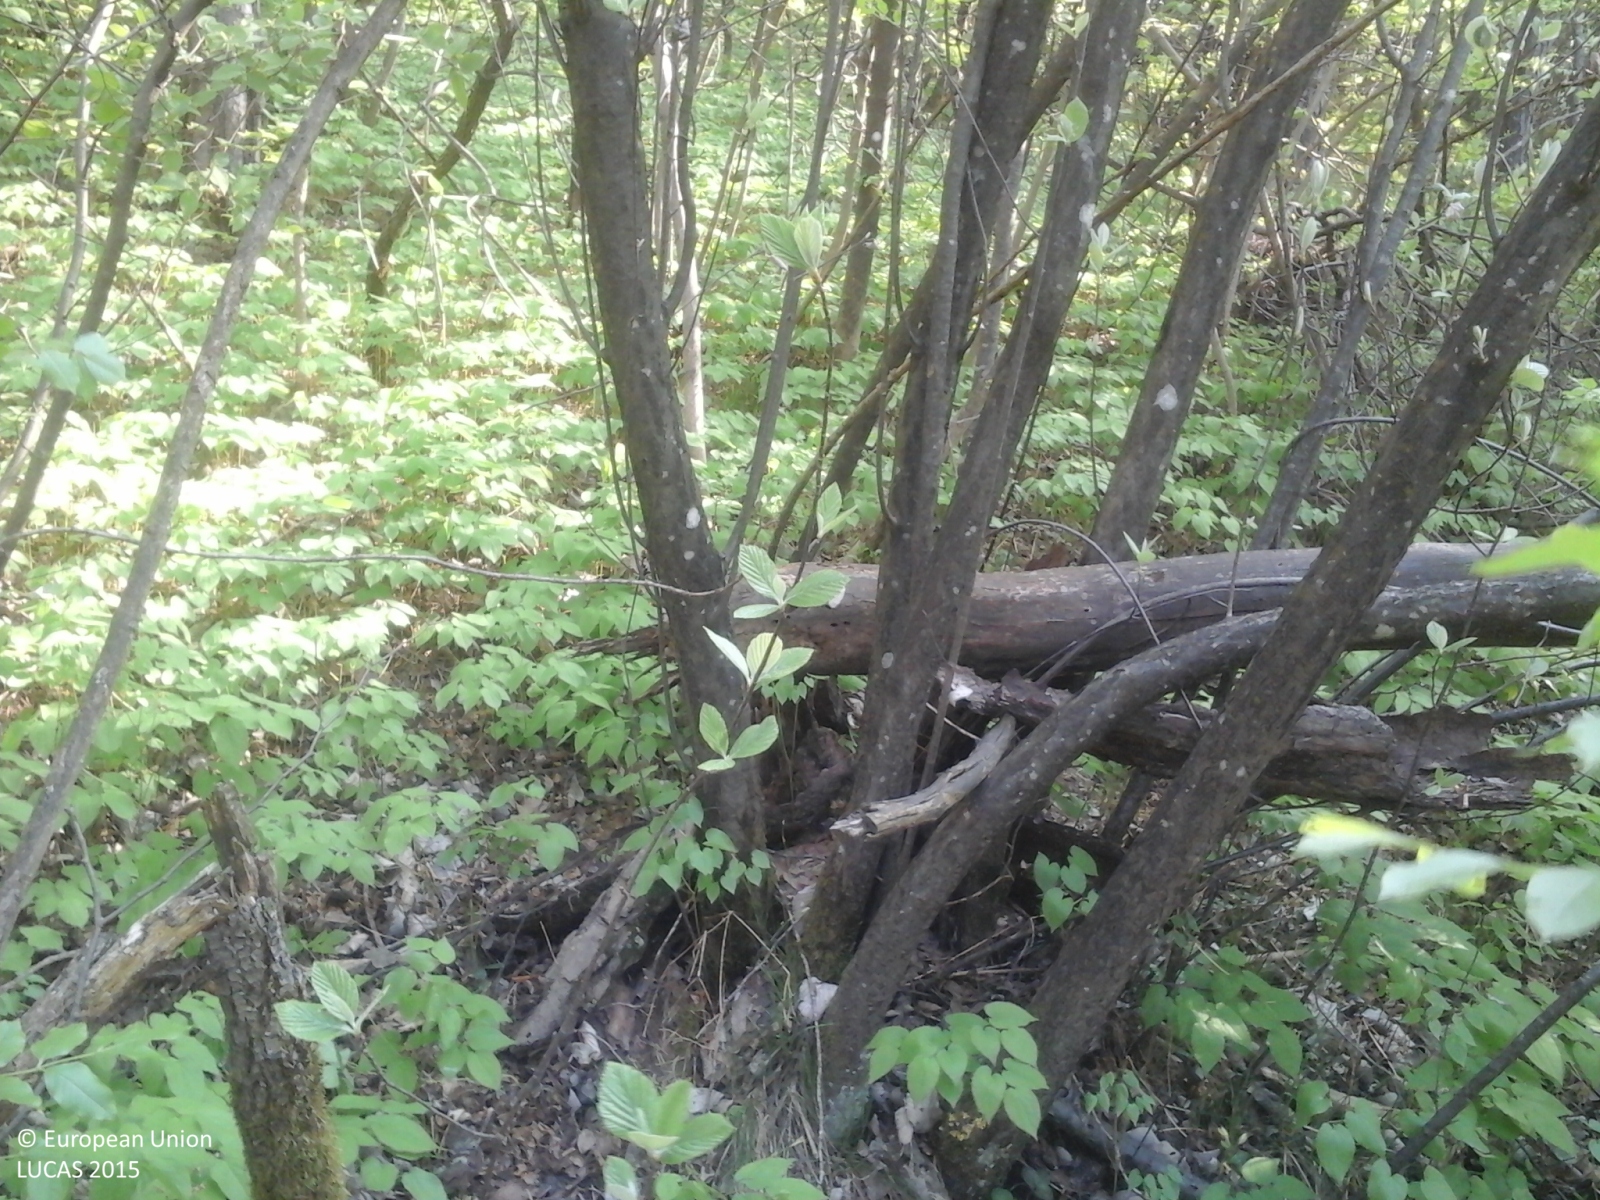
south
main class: Woodland
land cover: Broadleaved woodland
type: thermophilous deciduous forest
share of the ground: > 75 %
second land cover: Grassland without tree/shrub cover
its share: > 75 %
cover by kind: broadleaved forest trees 95 %, coniferous forest trees 5 %
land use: Forestry
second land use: Sport
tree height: > 5 m
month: April
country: IT
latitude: 46.1111
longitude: 11.1241
